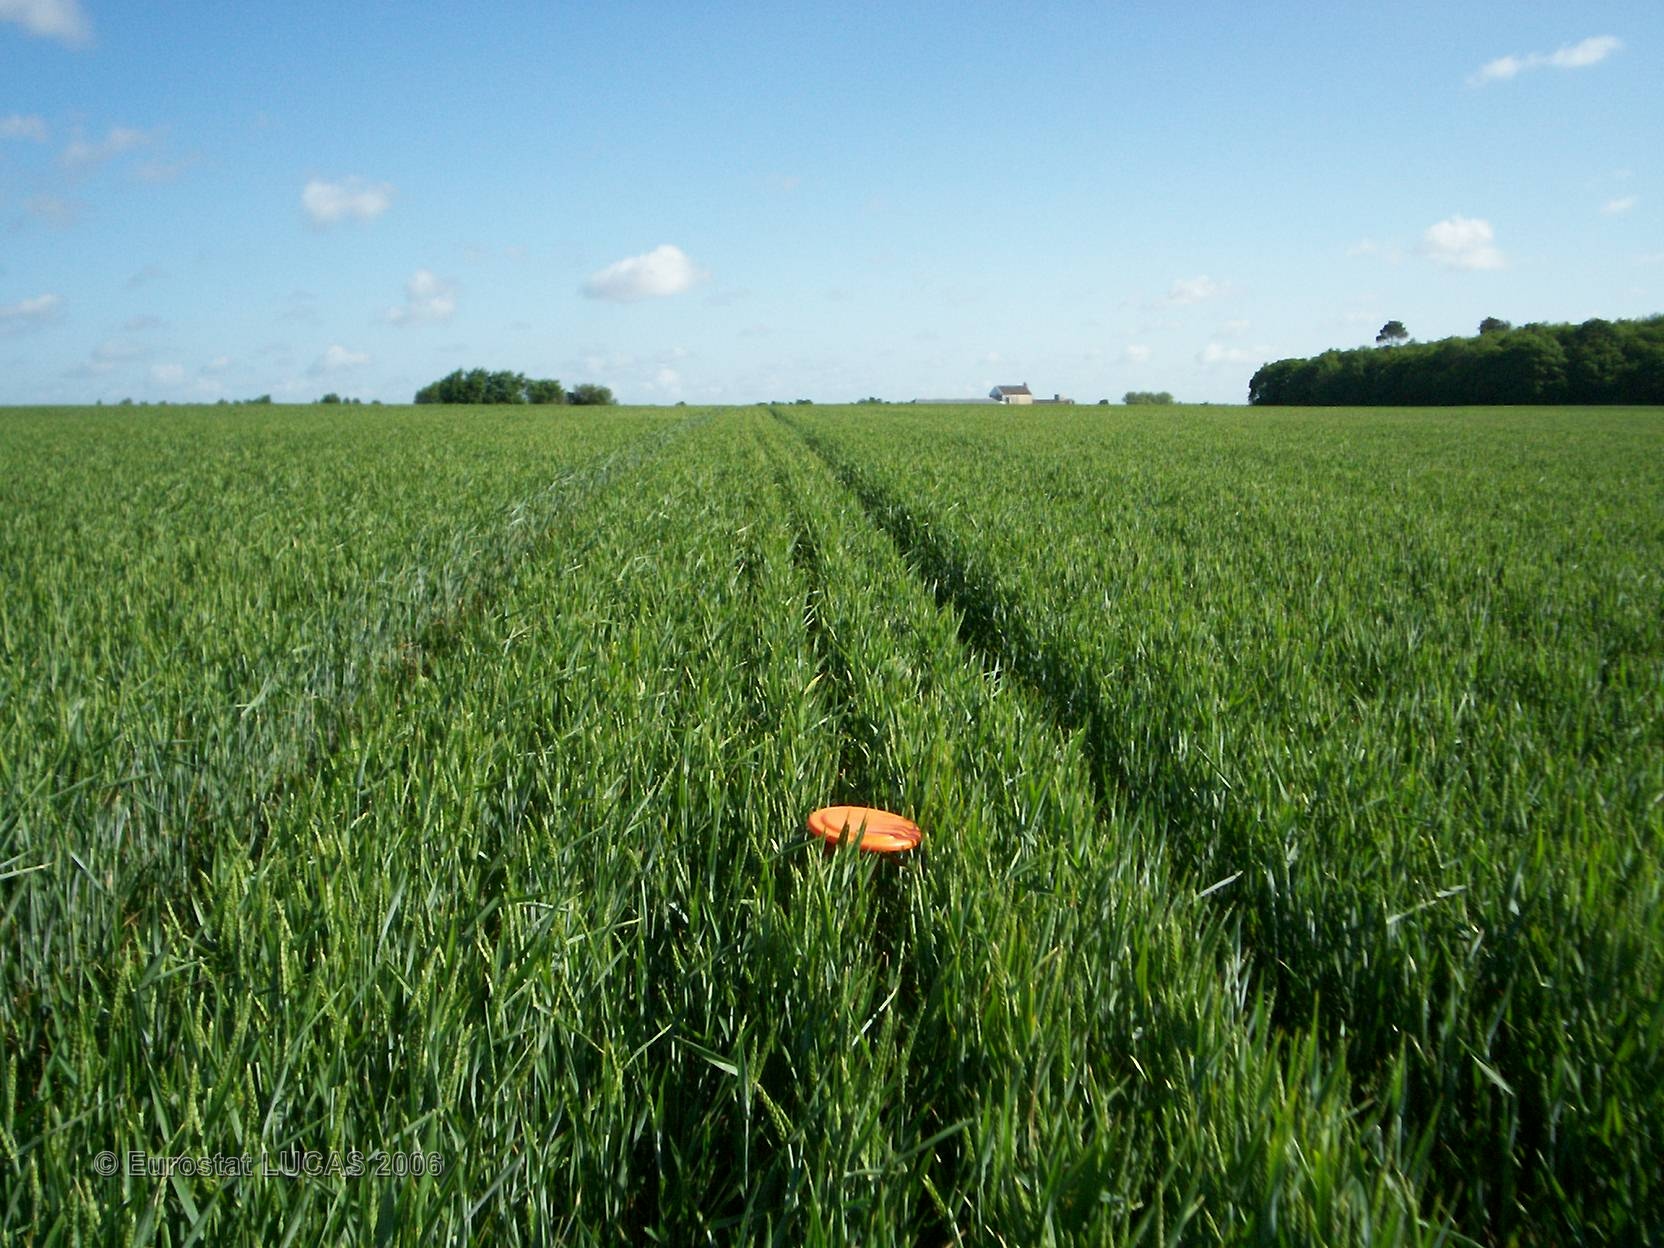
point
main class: Cropland
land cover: Common wheat
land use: Agriculture (excluding fallow land and kitchen gardens)
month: May
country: FR
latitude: 47.5171
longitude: 0.8584
